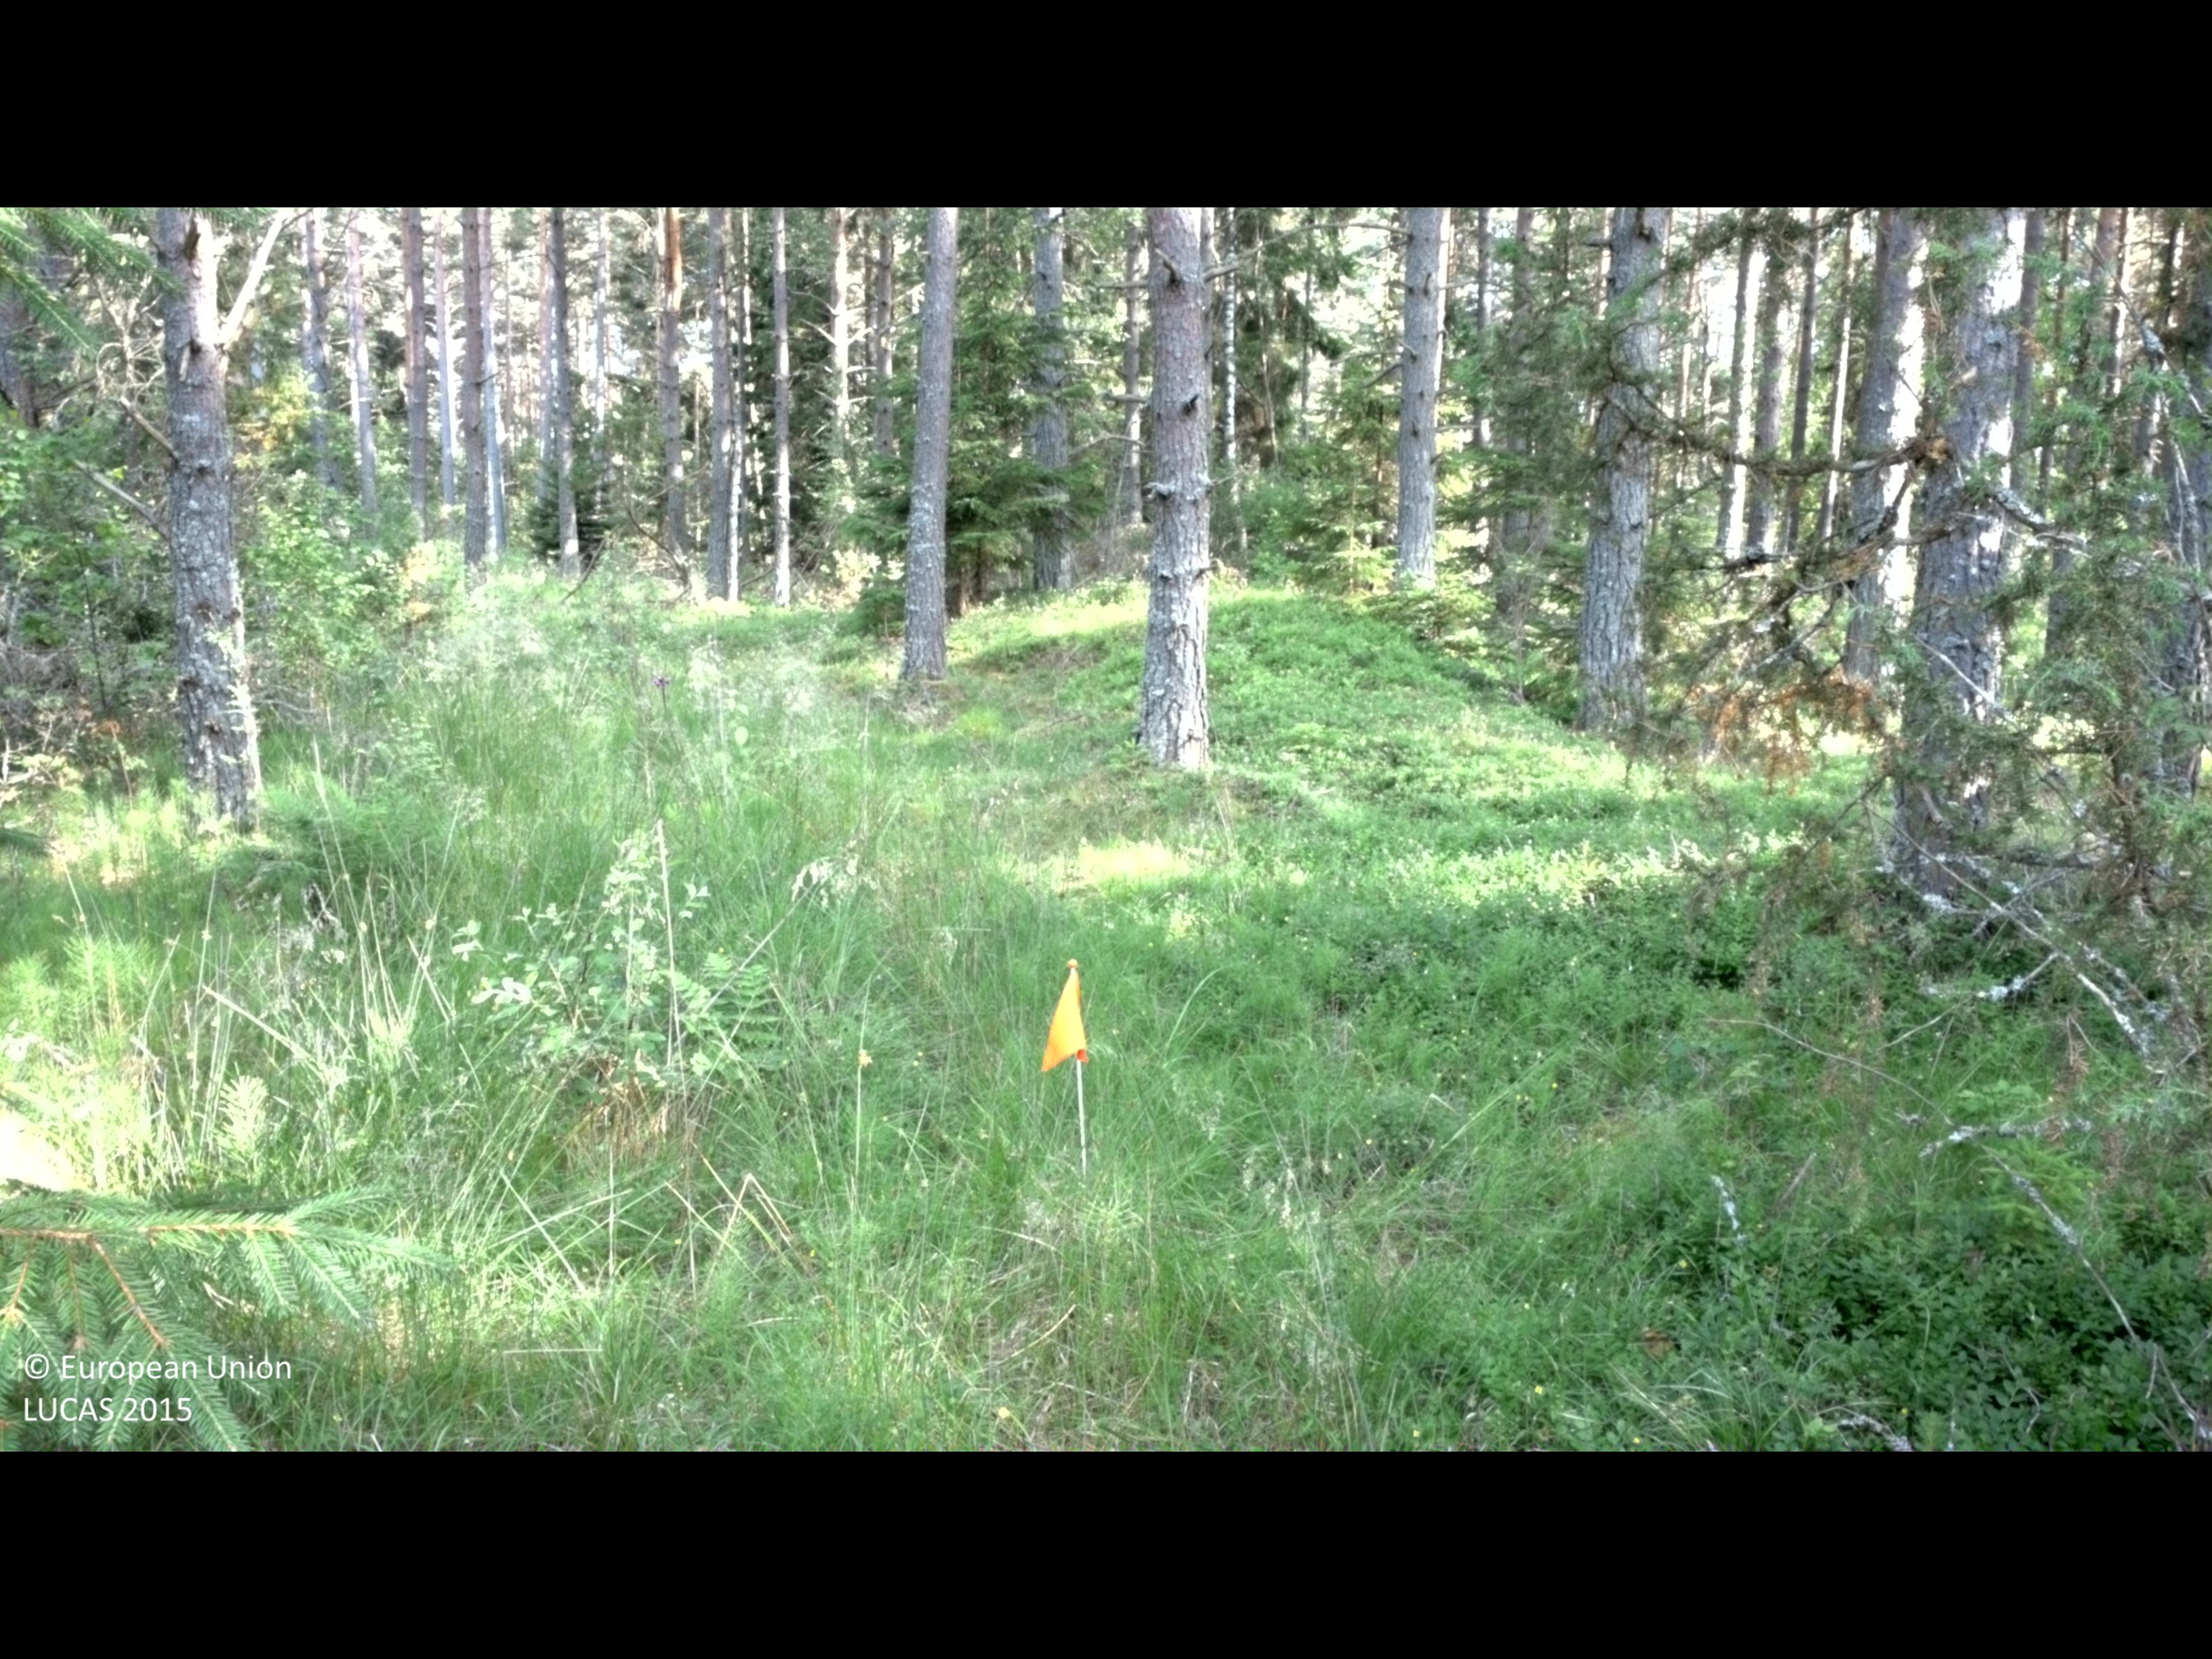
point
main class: Woodland
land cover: Pine dominated coniferous woodland
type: boreal forest
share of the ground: 50 - 75 %
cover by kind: coniferous forest trees 65 %, shrubs 20 %, herbaceous plants 10 %, broadleaved forest trees 5 %
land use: Forestry
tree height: > 5 m
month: July
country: SE
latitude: 58.3962
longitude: 16.6865
